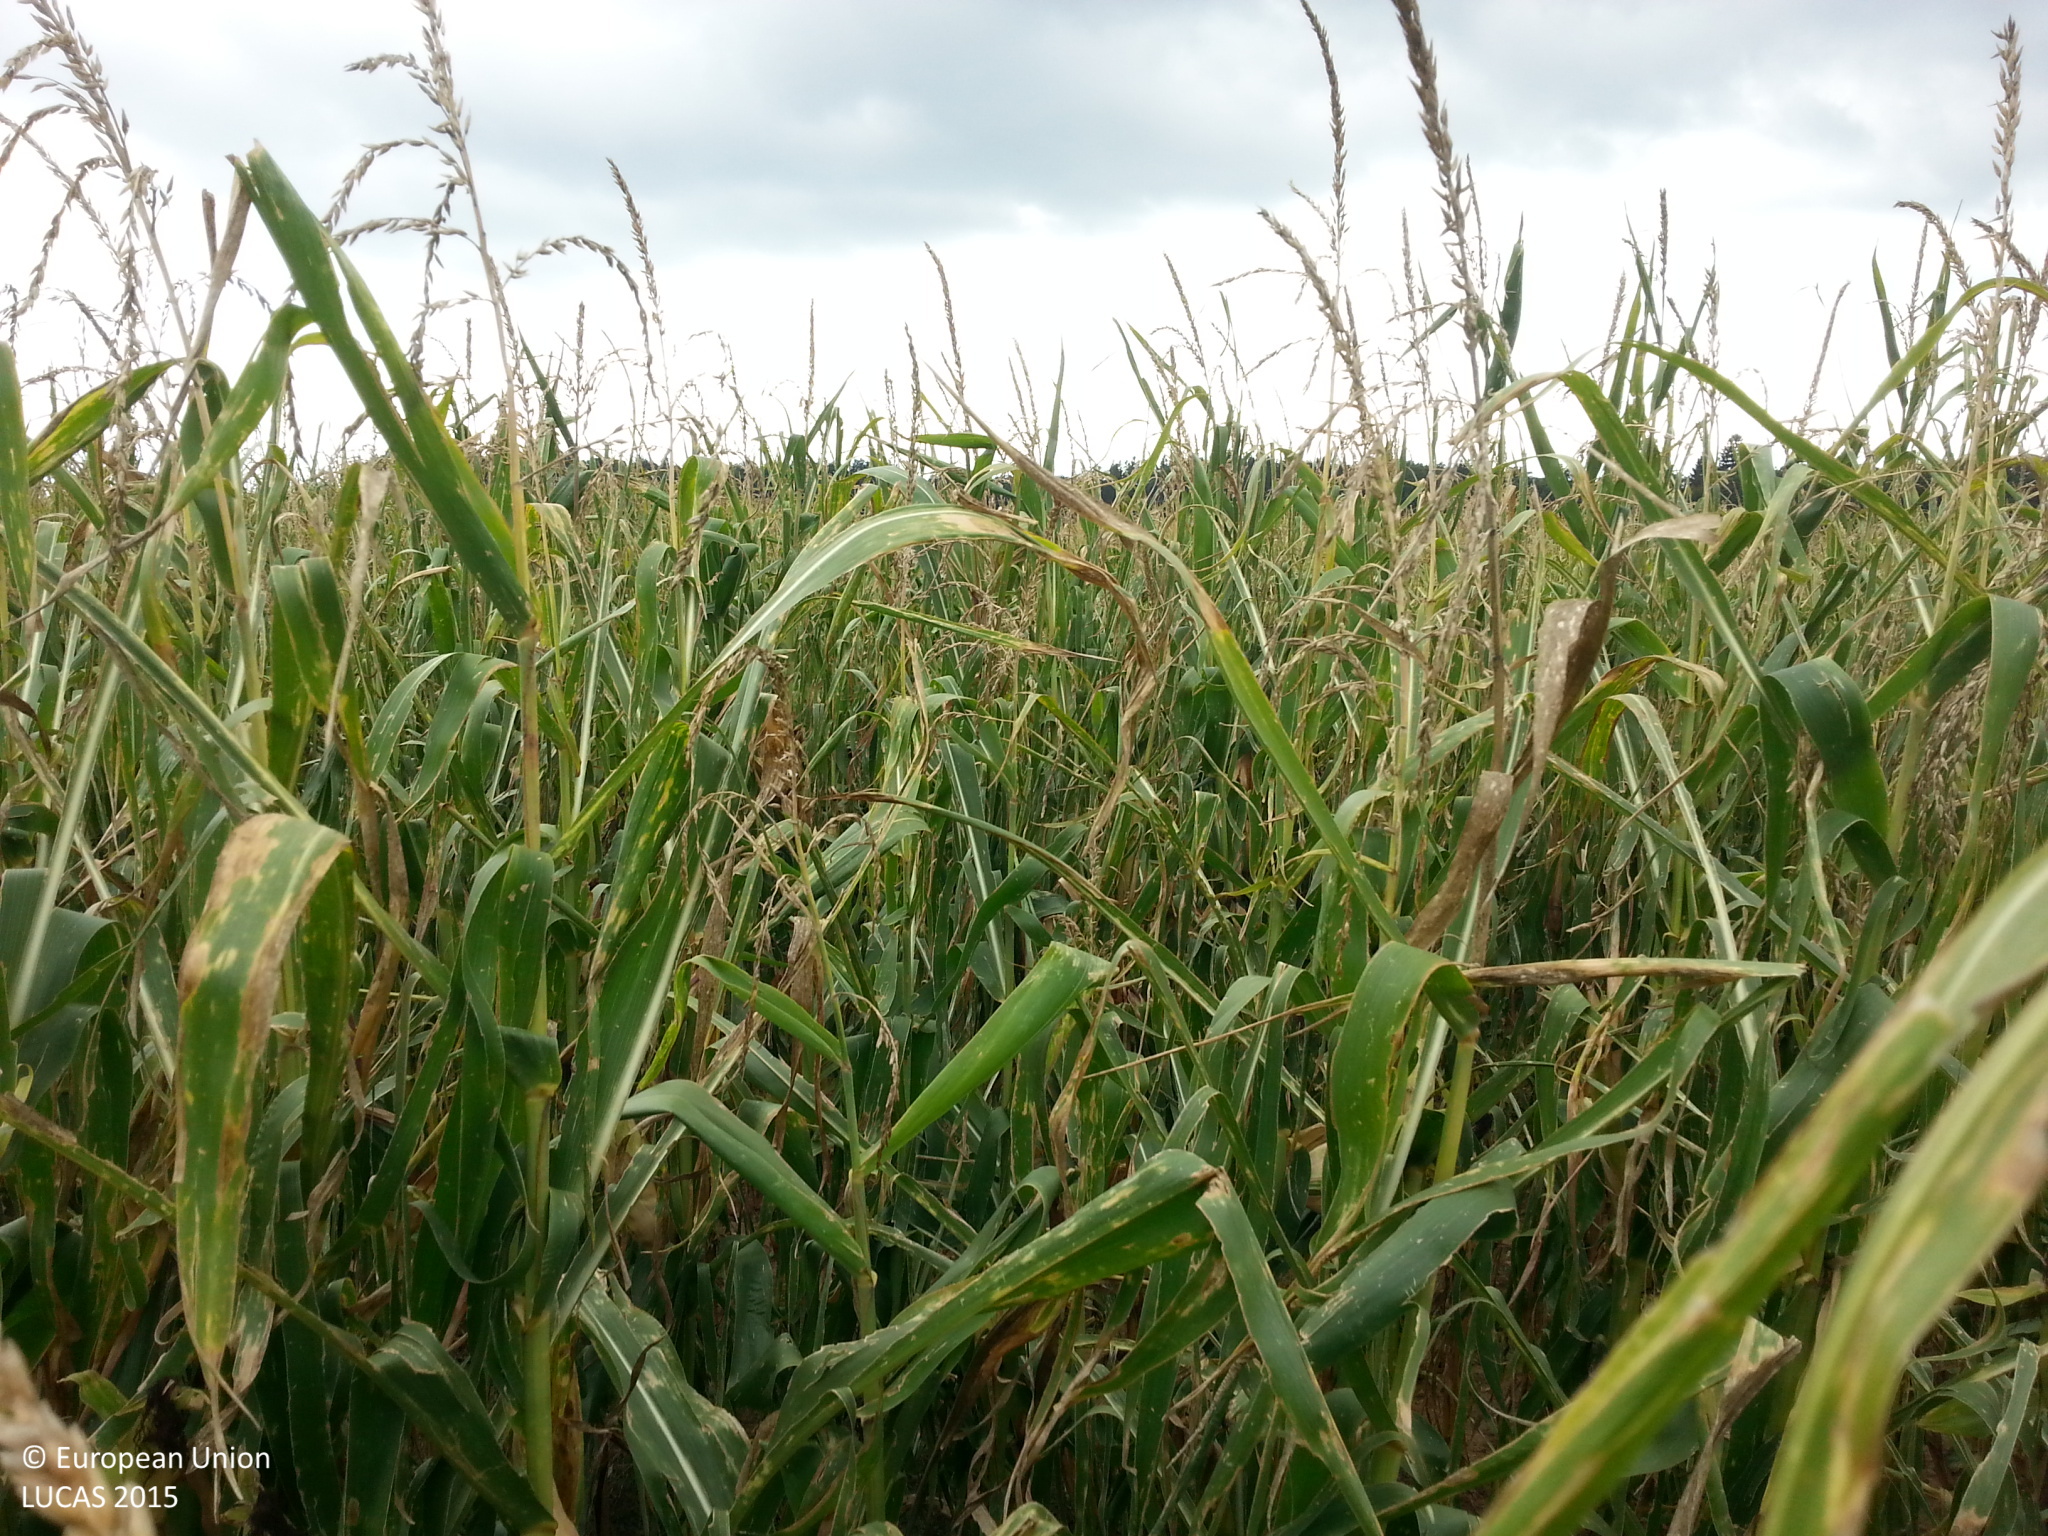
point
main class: Cropland
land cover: Maize
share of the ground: > 75 %
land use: Agriculture (excluding fallow land and kitchen gardens)
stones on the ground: < 10 %
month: September
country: DE
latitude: 49.6783
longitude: 9.2658
